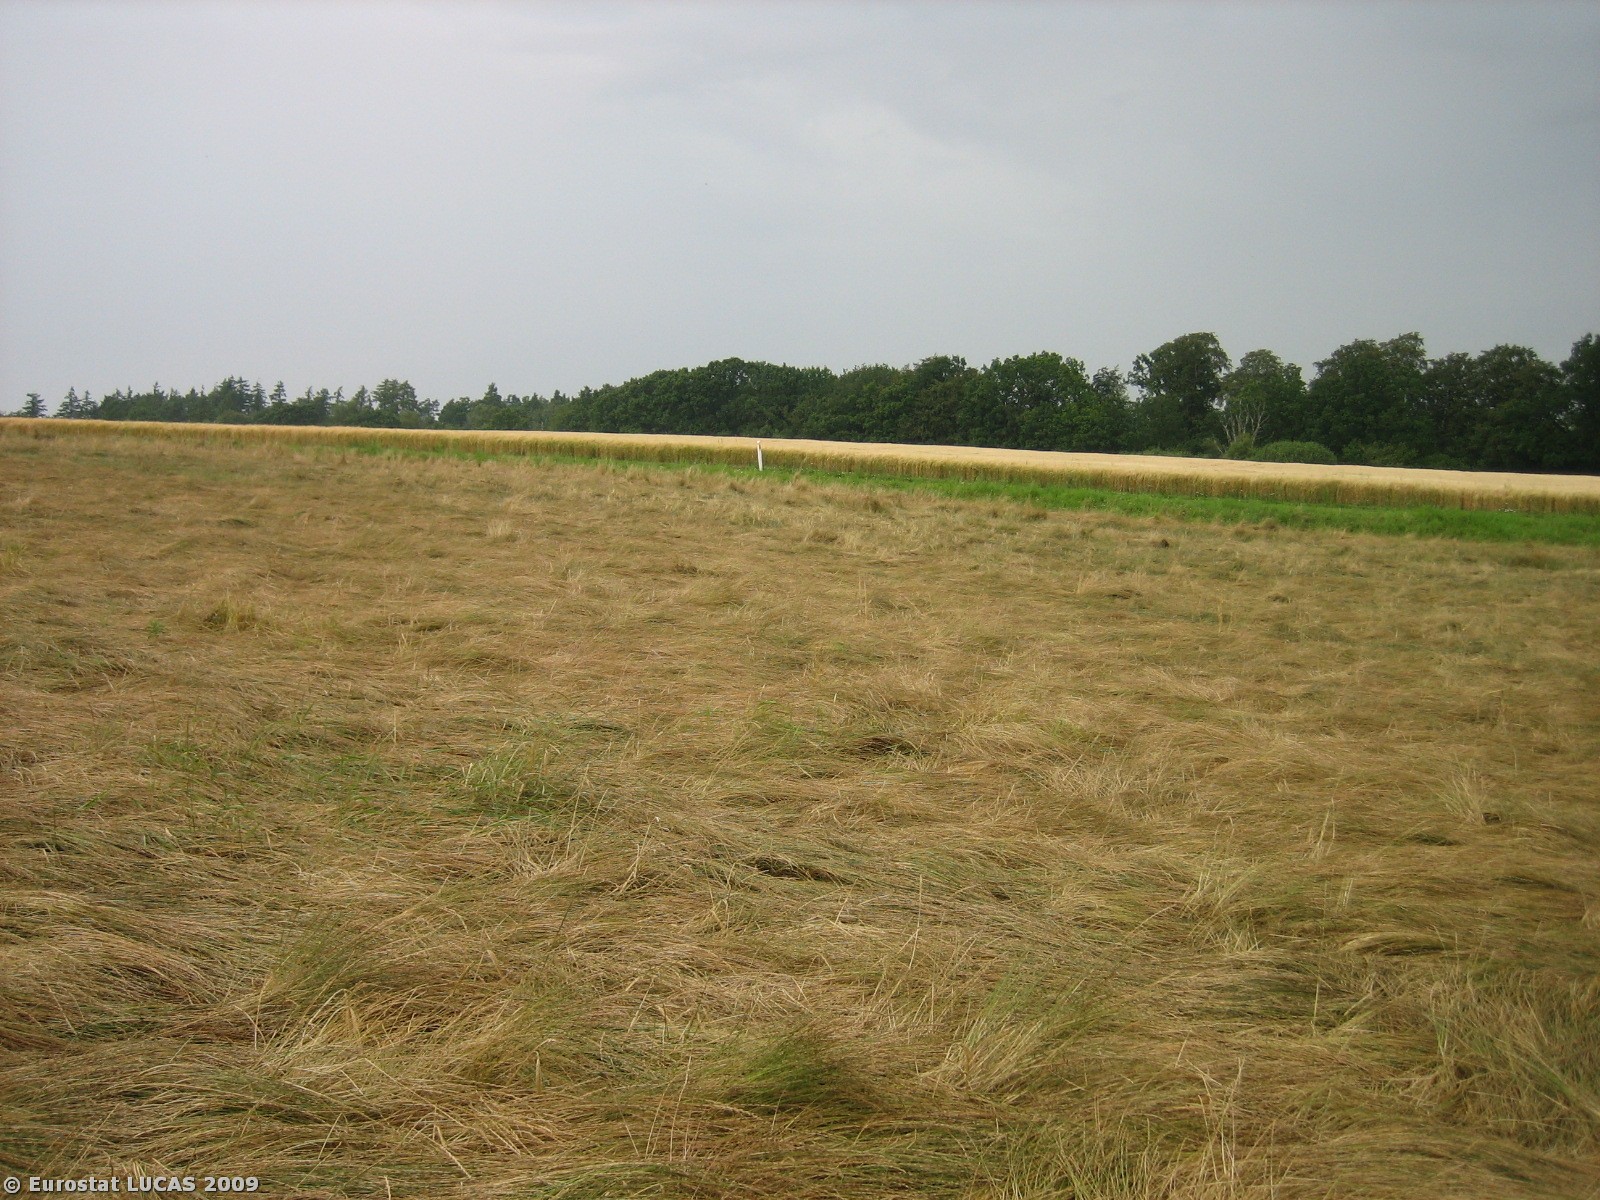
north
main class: Cropland
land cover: Temporary grasslands
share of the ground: > 75 %
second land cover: Barley
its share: < 10 %
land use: Agriculture (excluding fallow land and kitchen gardens)
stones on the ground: < 10 %
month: July
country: DK
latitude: 55.3789
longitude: 9.9842
